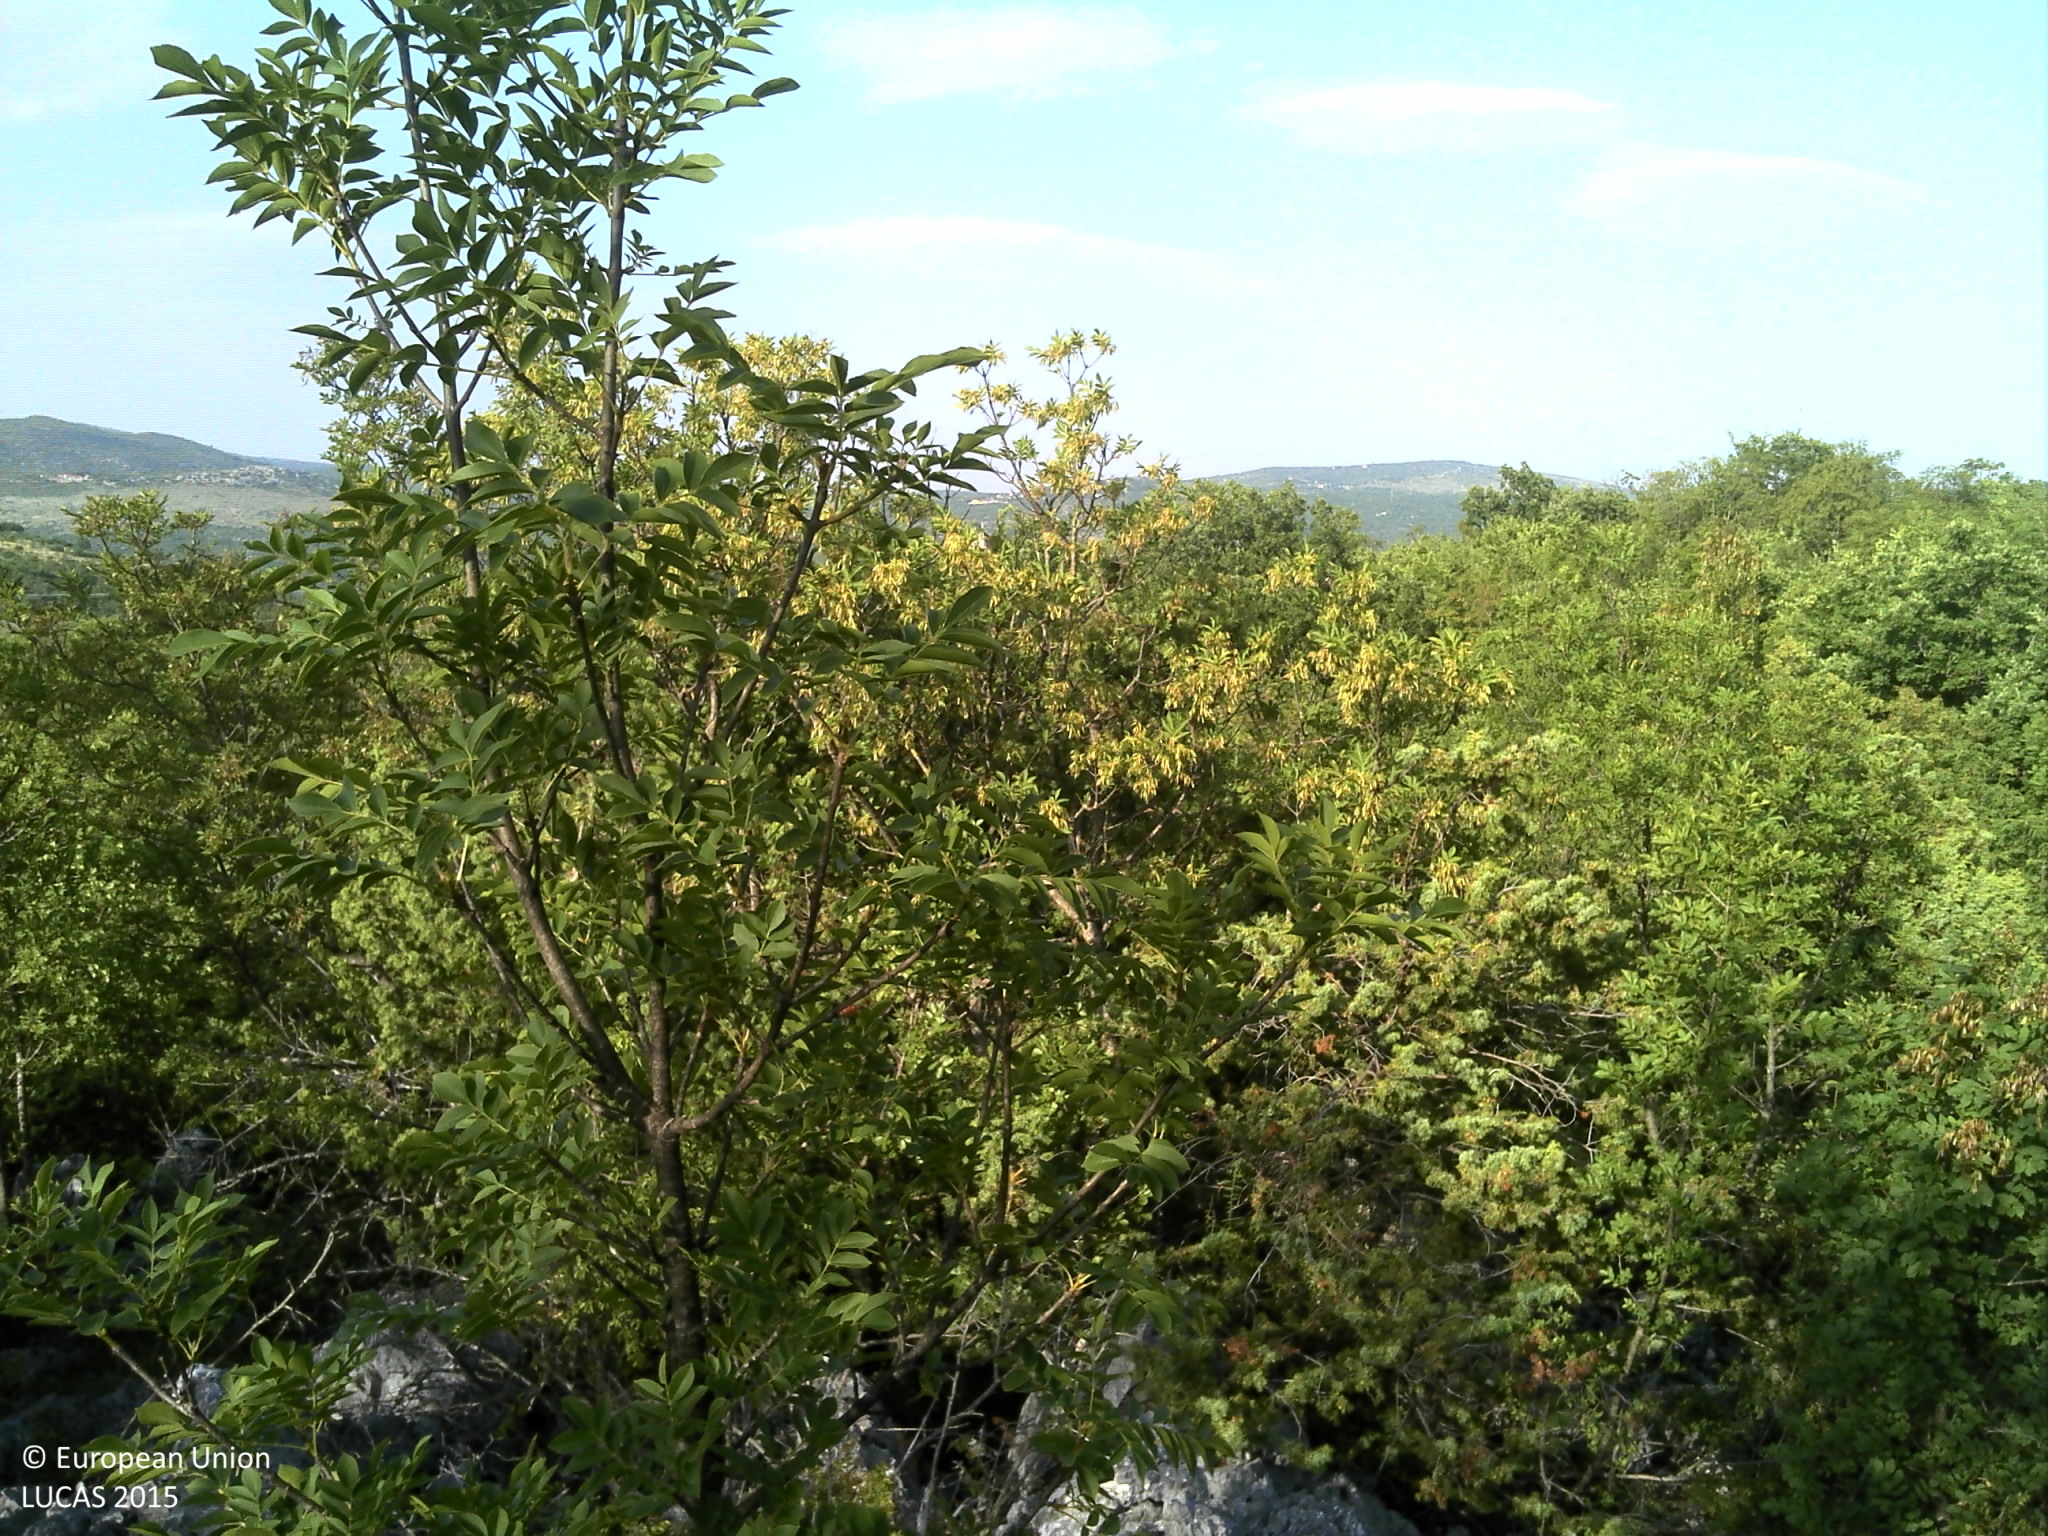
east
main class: Shrubland
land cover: Shrubland with sparse tree cover
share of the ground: > 75 %
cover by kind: shrubs 70 %, consolidated bare surface 15 %, unconsolidated bare surface 10 %, broadleaved forest trees 5 %
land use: Semi-natural and natural areas not in use
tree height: < 5 m
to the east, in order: Shrubland with sparse tree cover; Broadleaved woodland; Tracks; Broadleaved woodland; Dry stone walls; Broadleaved woodland
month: June
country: HR
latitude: 43.5985
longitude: 16.2963
